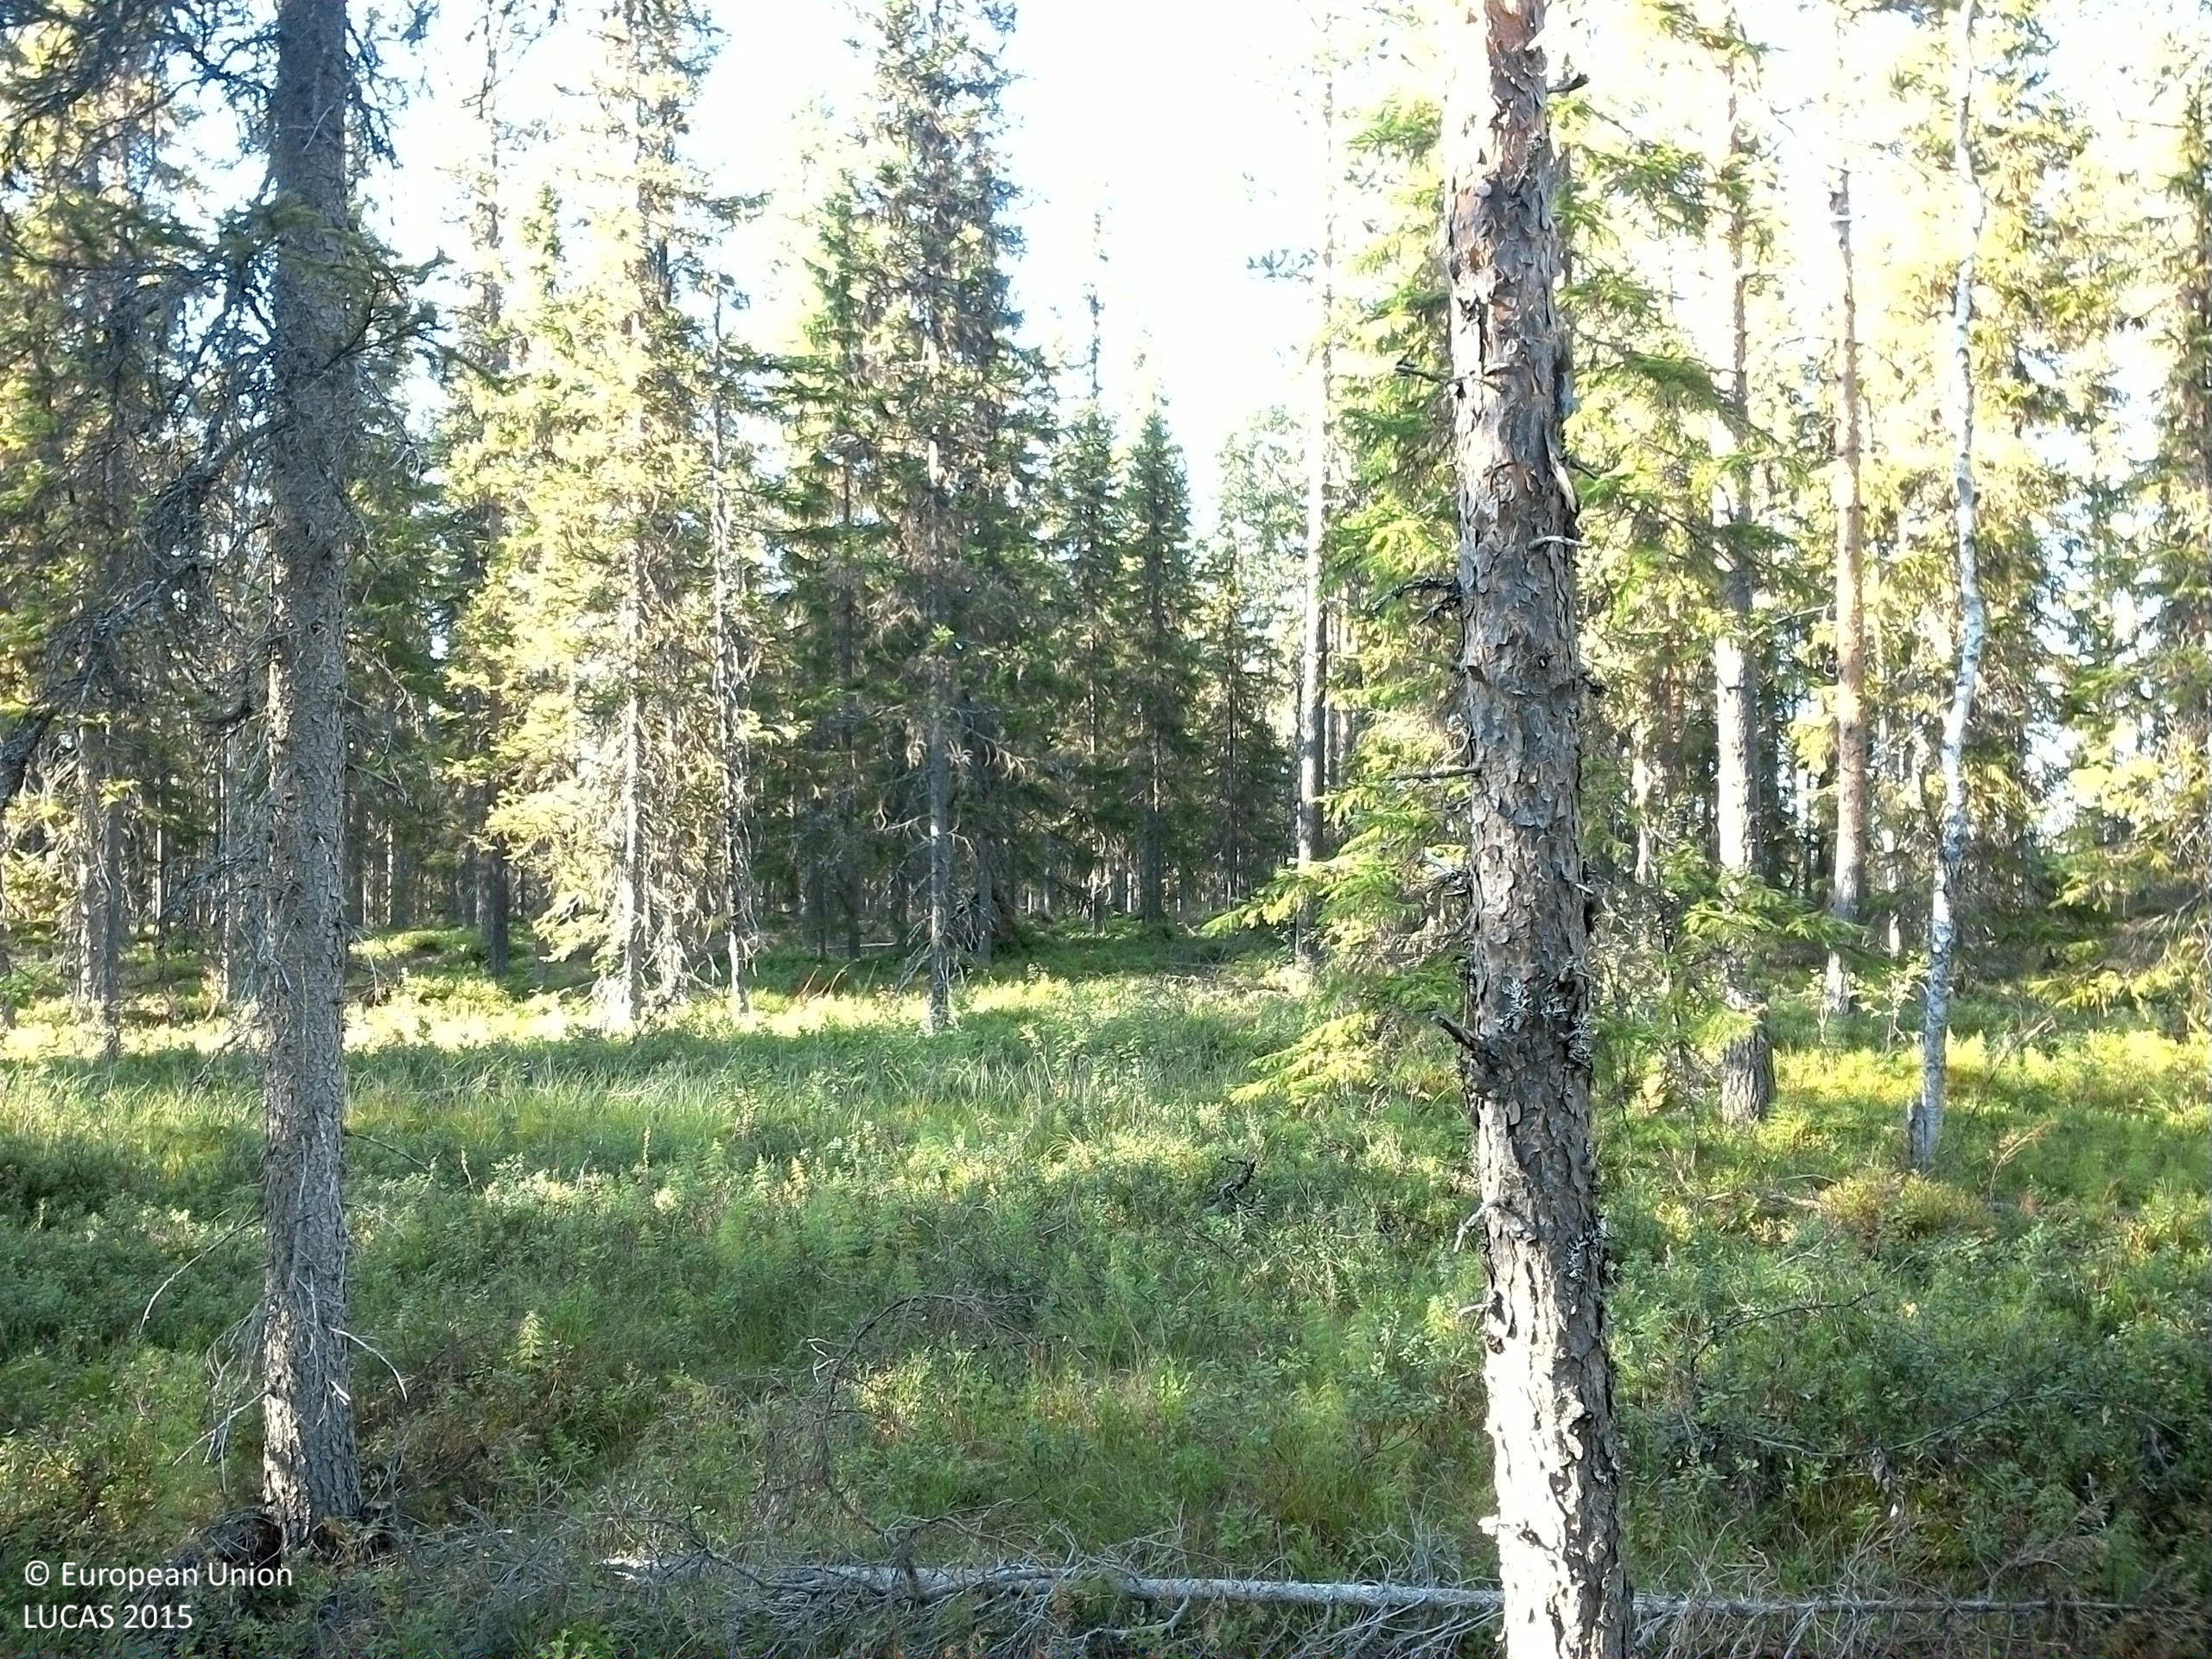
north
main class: Woodland
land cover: Pine dominated coniferous woodland
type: boreal forest
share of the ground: 50 - 75 %
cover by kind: coniferous forest trees 60 %, shrubs 25 %, broadleaved forest trees 5 %, herbaceous plants 5 %, lichens and mosses 5 %
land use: Forestry
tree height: > 5 m
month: August
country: SE
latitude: 63.6918
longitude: 17.5566
